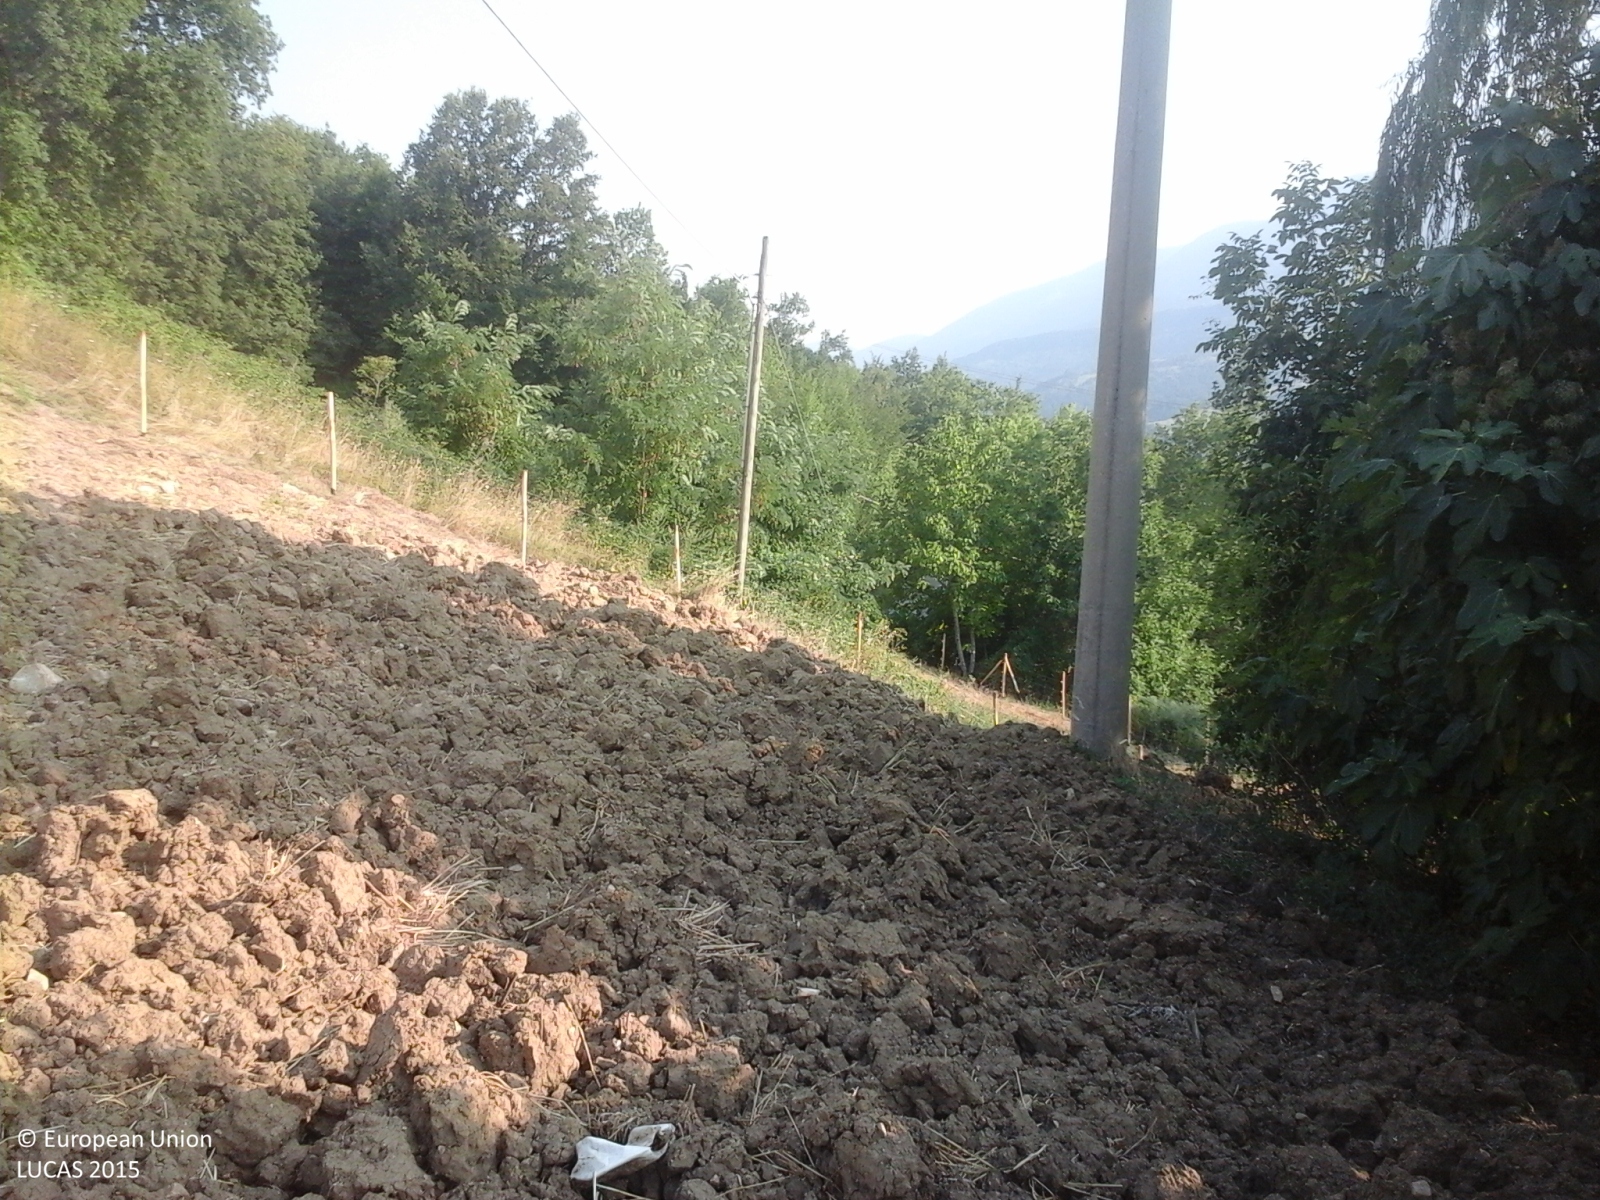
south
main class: Cropland
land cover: Mixed cereals for fodder
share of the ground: > 75 %
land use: Agriculture (excluding fallow land and kitchen gardens)
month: August
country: IT
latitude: 42.4744
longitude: 13.7957
